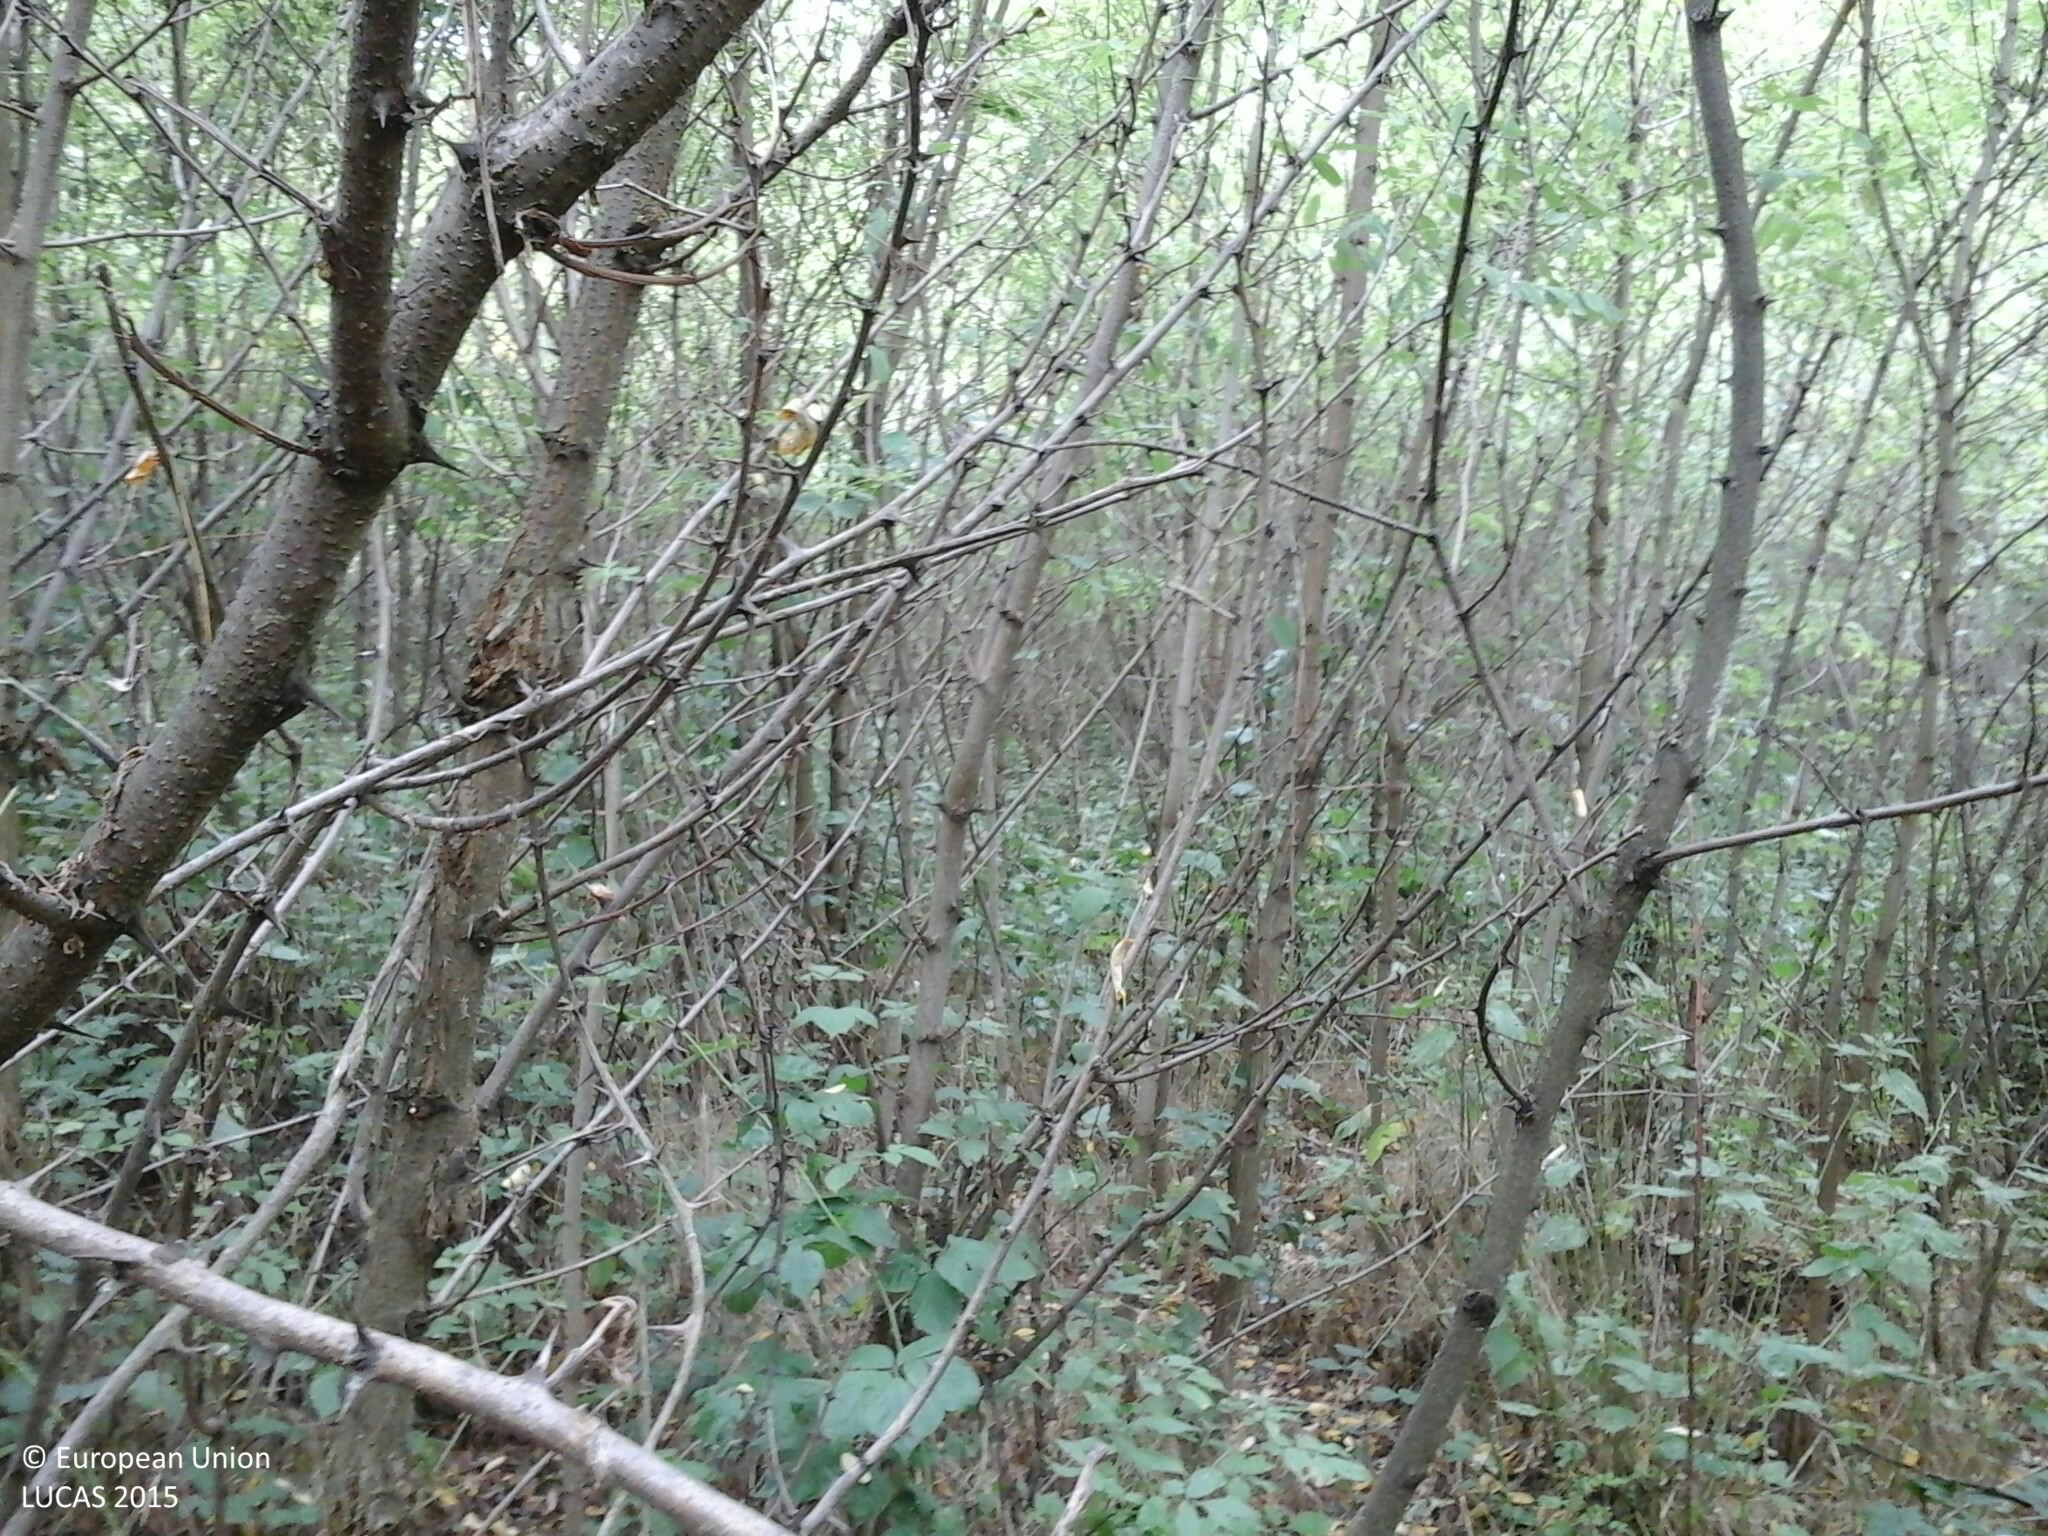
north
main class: Woodland
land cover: Broadleaved woodland
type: exotic forest
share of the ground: > 75 %
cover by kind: broadleaved forest trees 70 %, shrubs 20 %, herbaceous plants 10 %
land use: Forestry
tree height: < 5 m
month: July
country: HU
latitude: 46.8324
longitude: 16.6231
